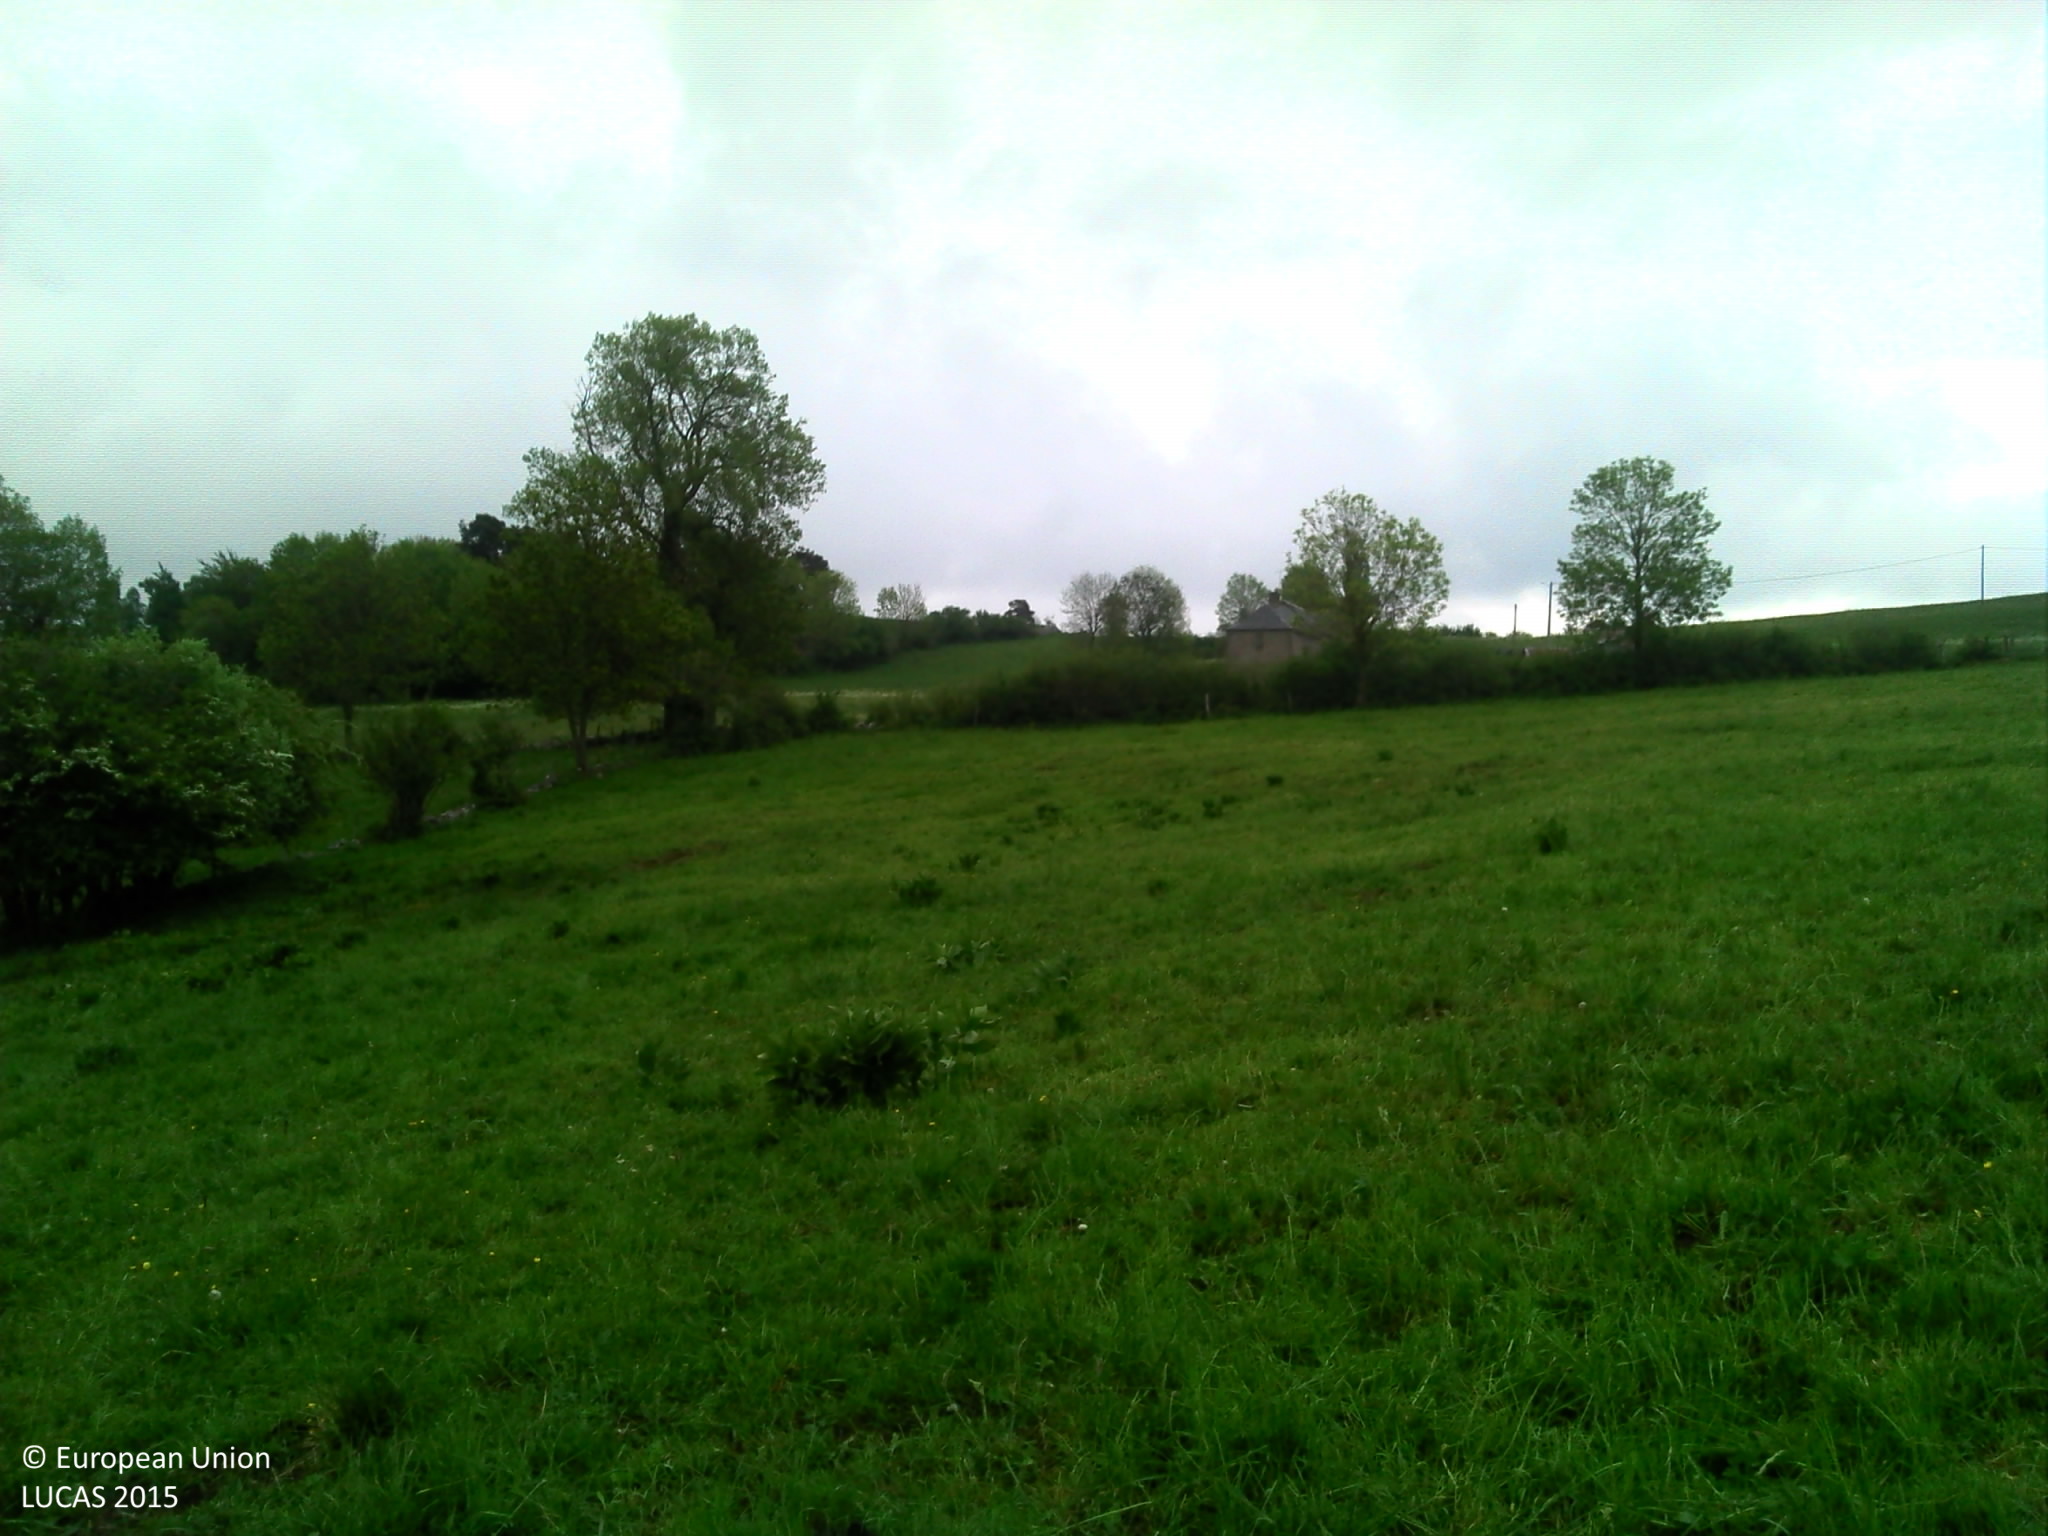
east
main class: Grassland
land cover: Grassland without tree/shrub cover
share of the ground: > 75 %
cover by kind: herbaceous plants 100 %
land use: Agriculture (excluding fallow land and kitchen gardens)
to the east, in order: Grassland without tree/shrub cover; Fences; Abandoned hedges; Tracks; Grass margins; Fences; Grassland without tree/shrub cover; Dry stone walls; Grassland without tree/shrub cover; Dry stone walls; Fences; Grassland without tree/shrub cover
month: May
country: FR
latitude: 45.2004
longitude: 3.0125
